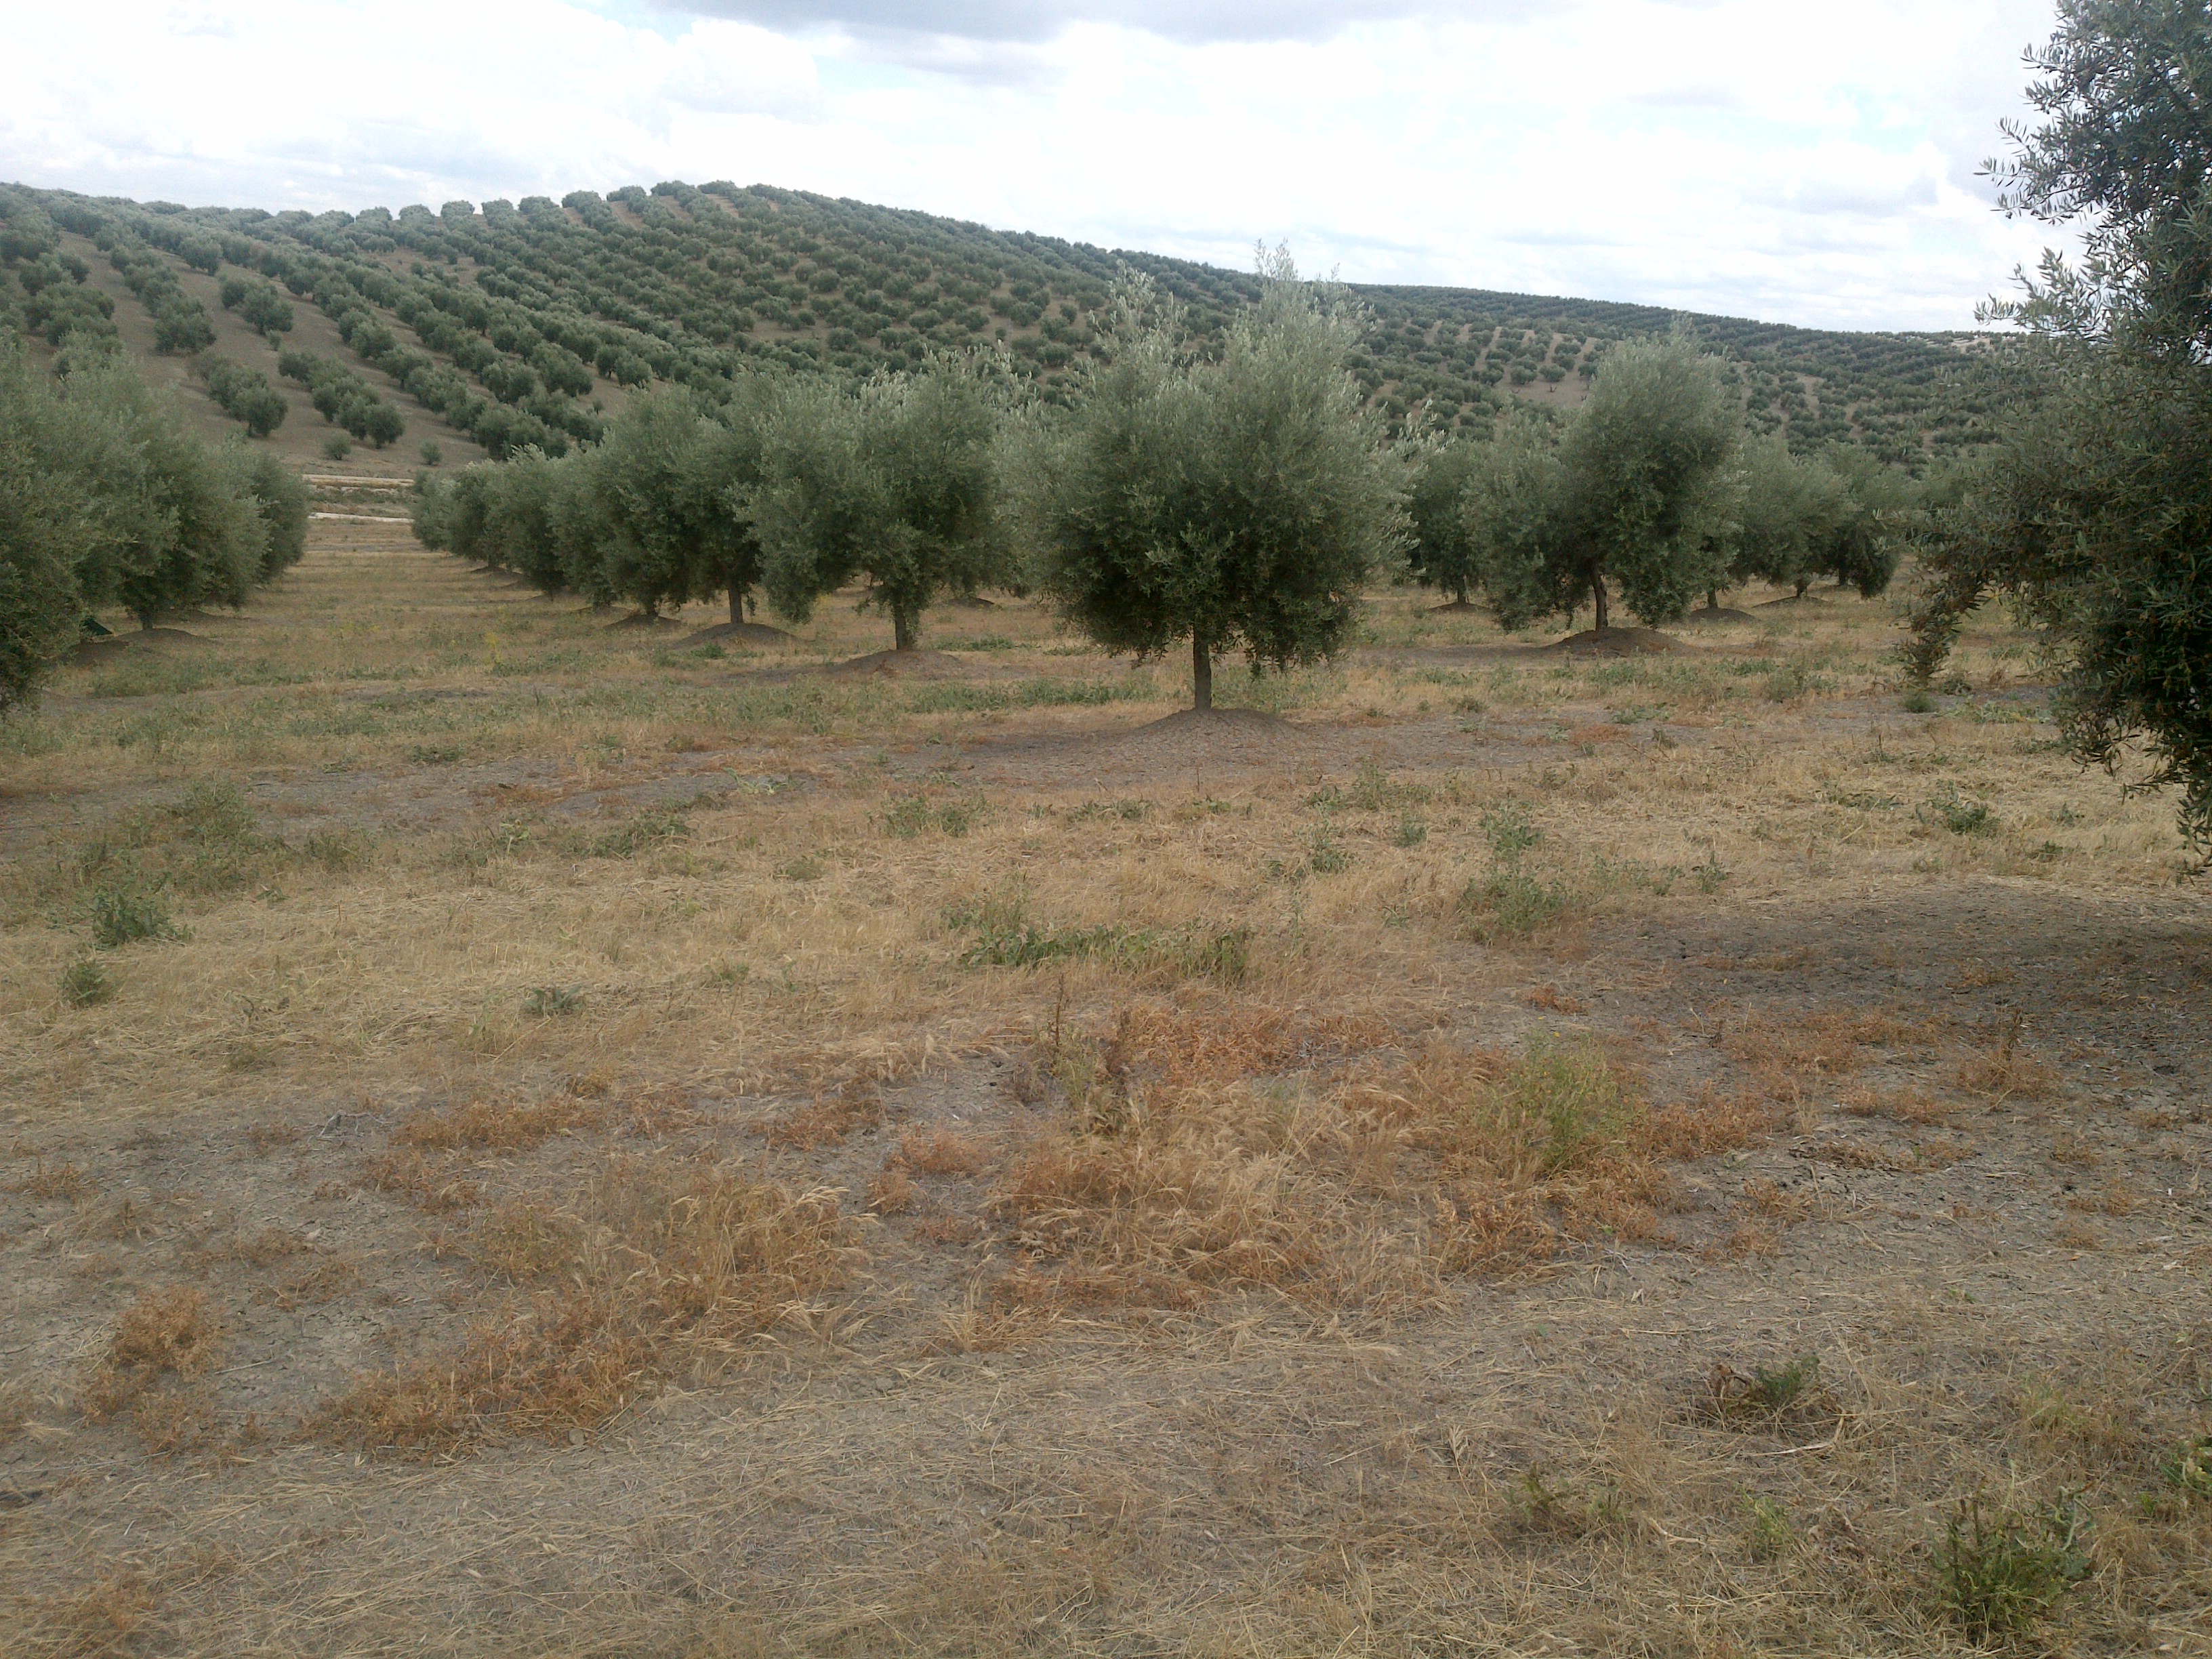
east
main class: Cropland
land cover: Olive groves
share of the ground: 25 - 50 %
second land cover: Spontaneously vegetated surfaces
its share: 10 - 25 %
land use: Agriculture (excluding fallow land and kitchen gardens)
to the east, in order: Olive groves; Spontaneously vegetated surfaces; Tracks; Grass margins; Olive groves; Grass margins; Tracks; Grass margins; Olive groves; Electric lines; Olive groves
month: June
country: ES
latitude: 37.8384
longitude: -4.2907
